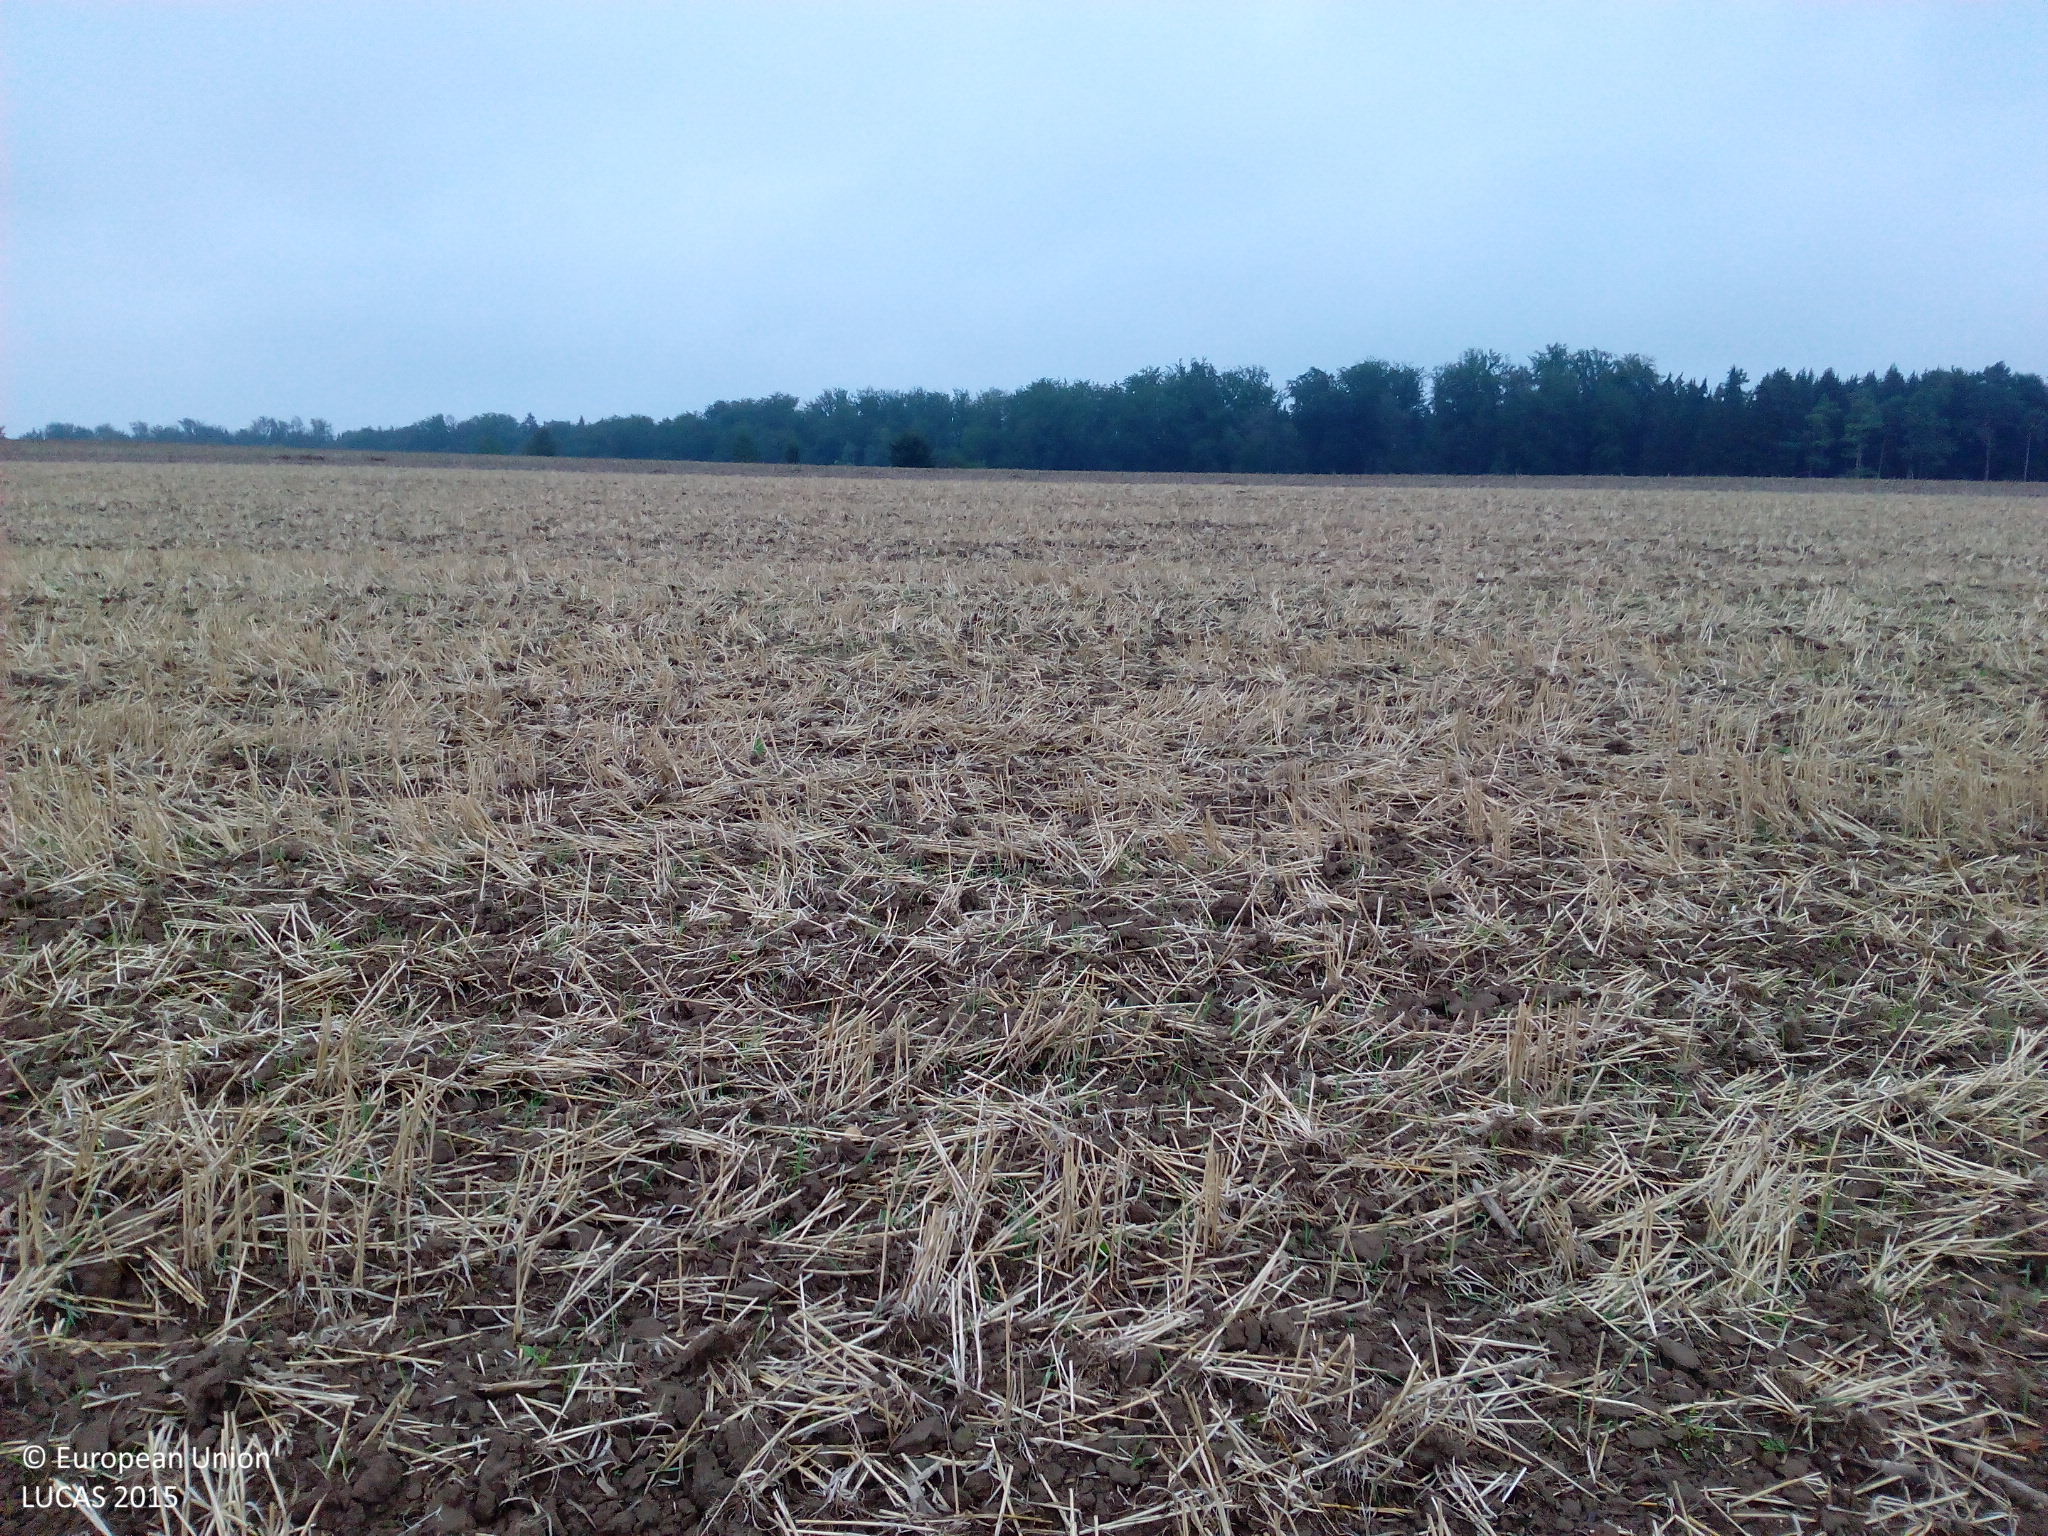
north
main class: Cropland
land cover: Common wheat
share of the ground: 25 - 50 %
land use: Agriculture (excluding fallow land and kitchen gardens)
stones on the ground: < 10 %
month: August
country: DE
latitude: 48.4934
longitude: 9.9594
